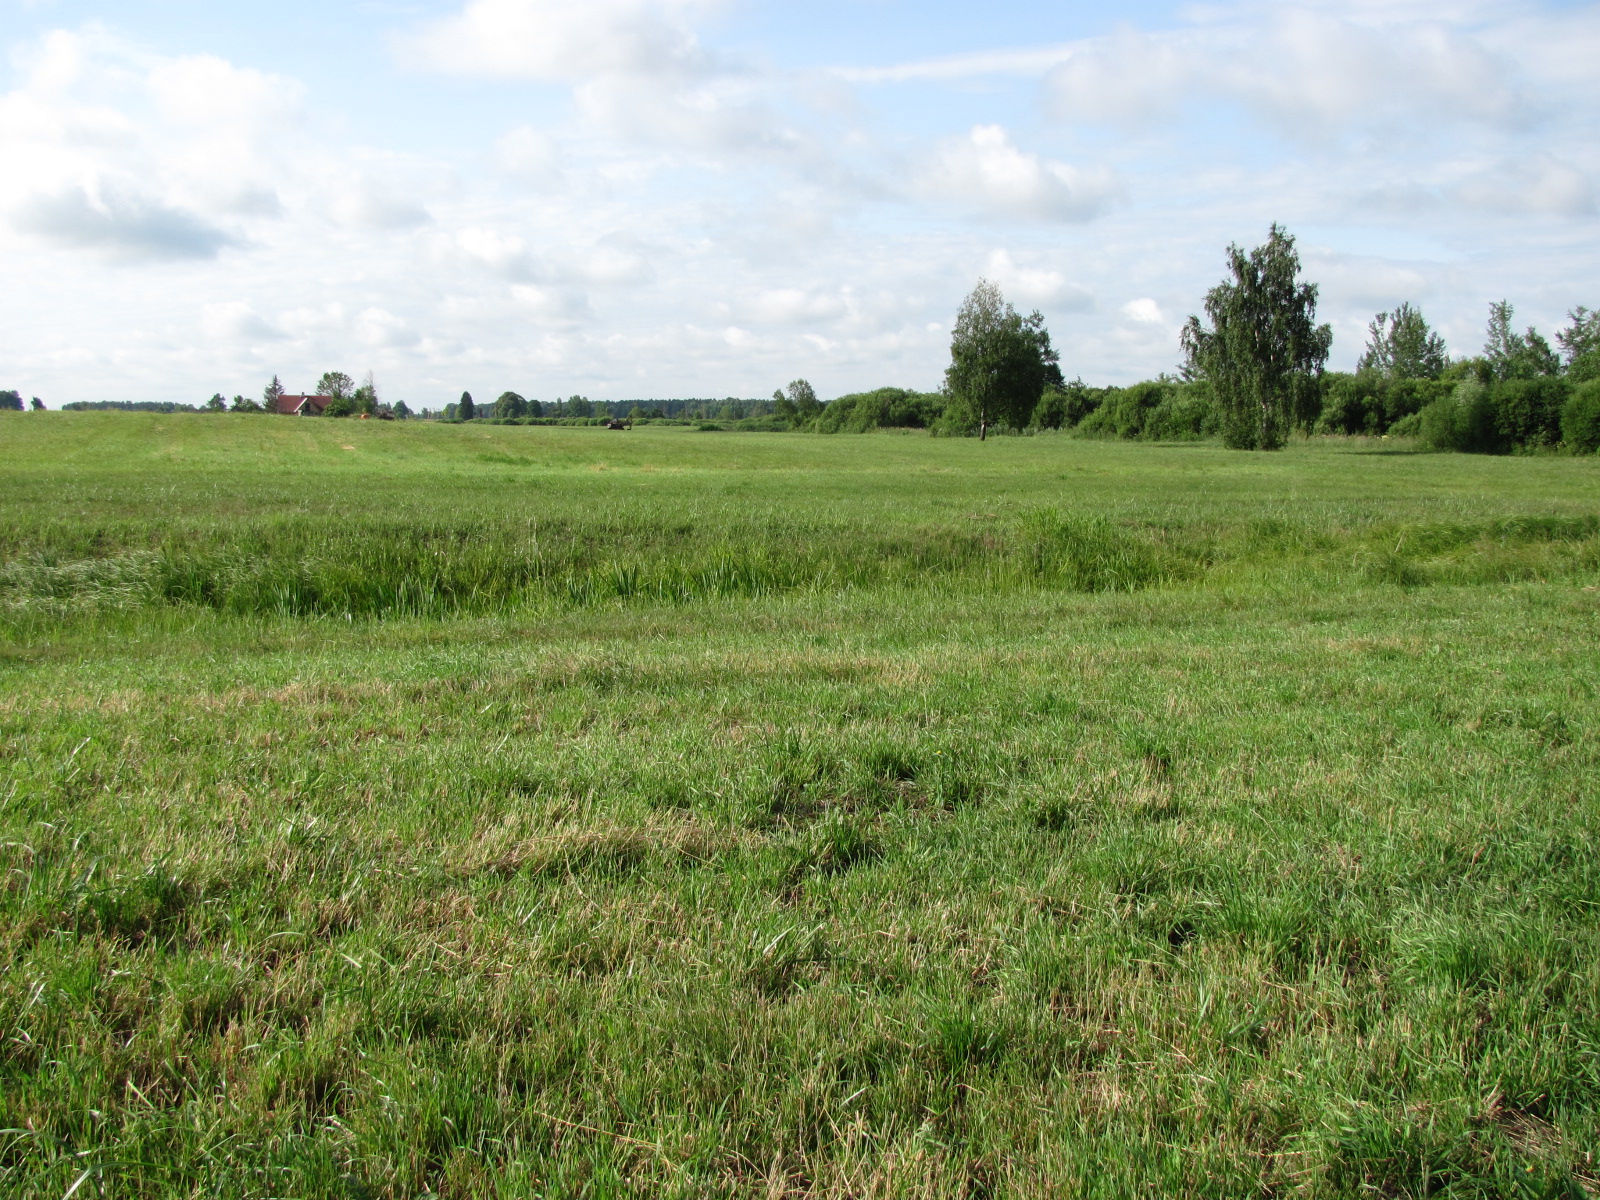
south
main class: Grassland
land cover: Grassland without tree/shrub cover
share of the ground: > 75 %
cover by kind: herbaceous plants 100 %
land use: Agriculture (excluding fallow land and kitchen gardens)
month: July
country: LV
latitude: 56.4823
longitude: 24.4325
